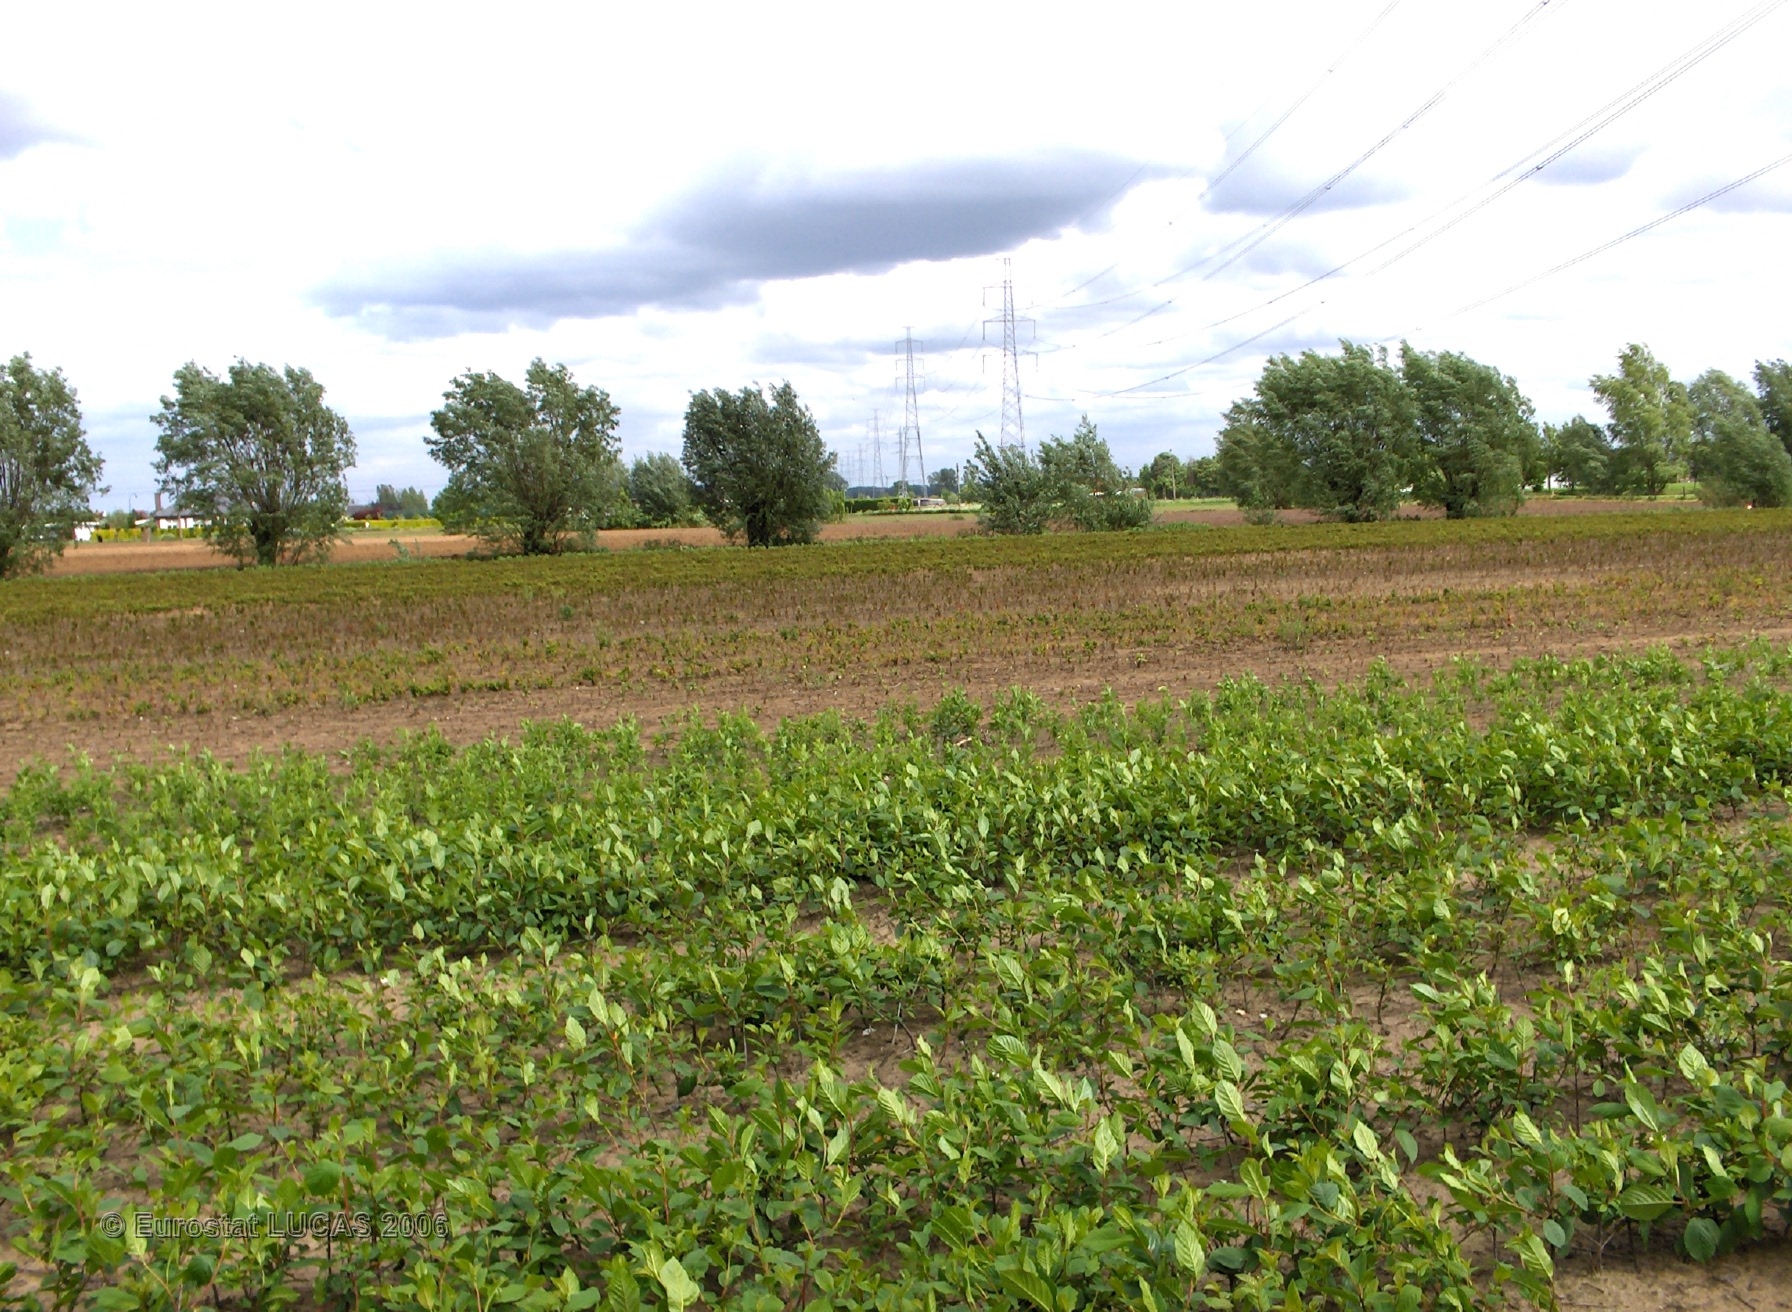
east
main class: Cropland
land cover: Nurseries
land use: Agriculture (excluding fallow land and kitchen gardens)
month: May
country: BE
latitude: 51.1441
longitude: 3.6605
